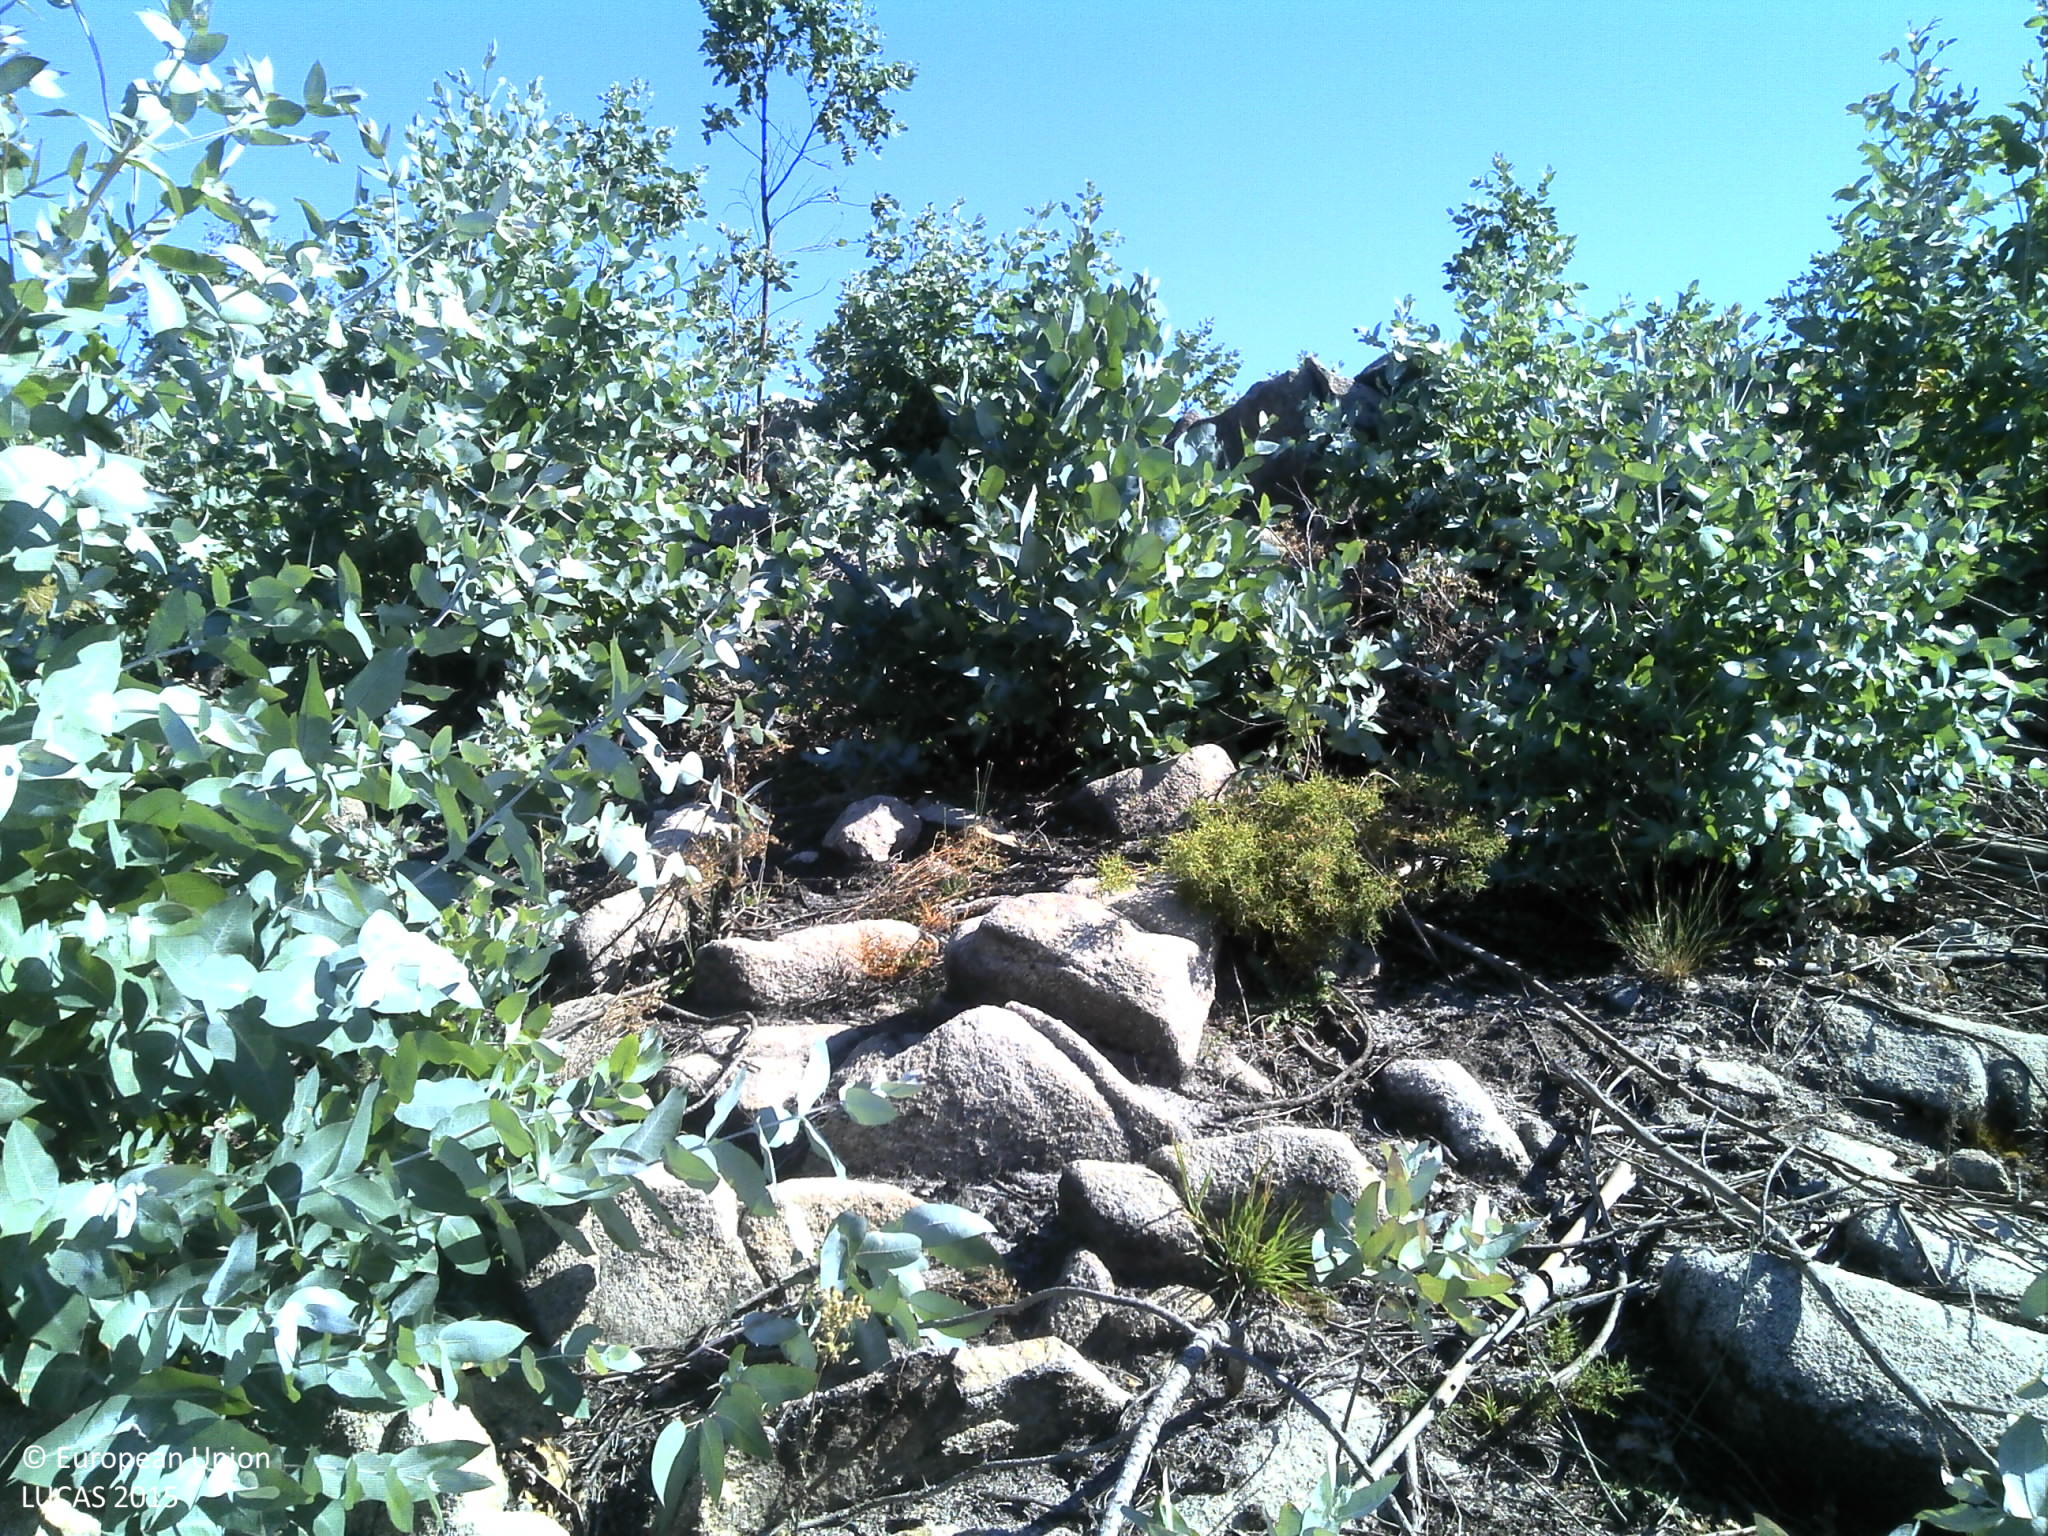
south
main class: Woodland
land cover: Broadleaved woodland
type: exotic forest
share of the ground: 25 - 50 %
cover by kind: broadleaved forest trees 50 %, unconsolidated bare surface 25 %, consolidated bare surface 20 %, shrubs 5 %
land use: Forestry
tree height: < 5 m
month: June
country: PT
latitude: 40.5919
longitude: -8.2461
